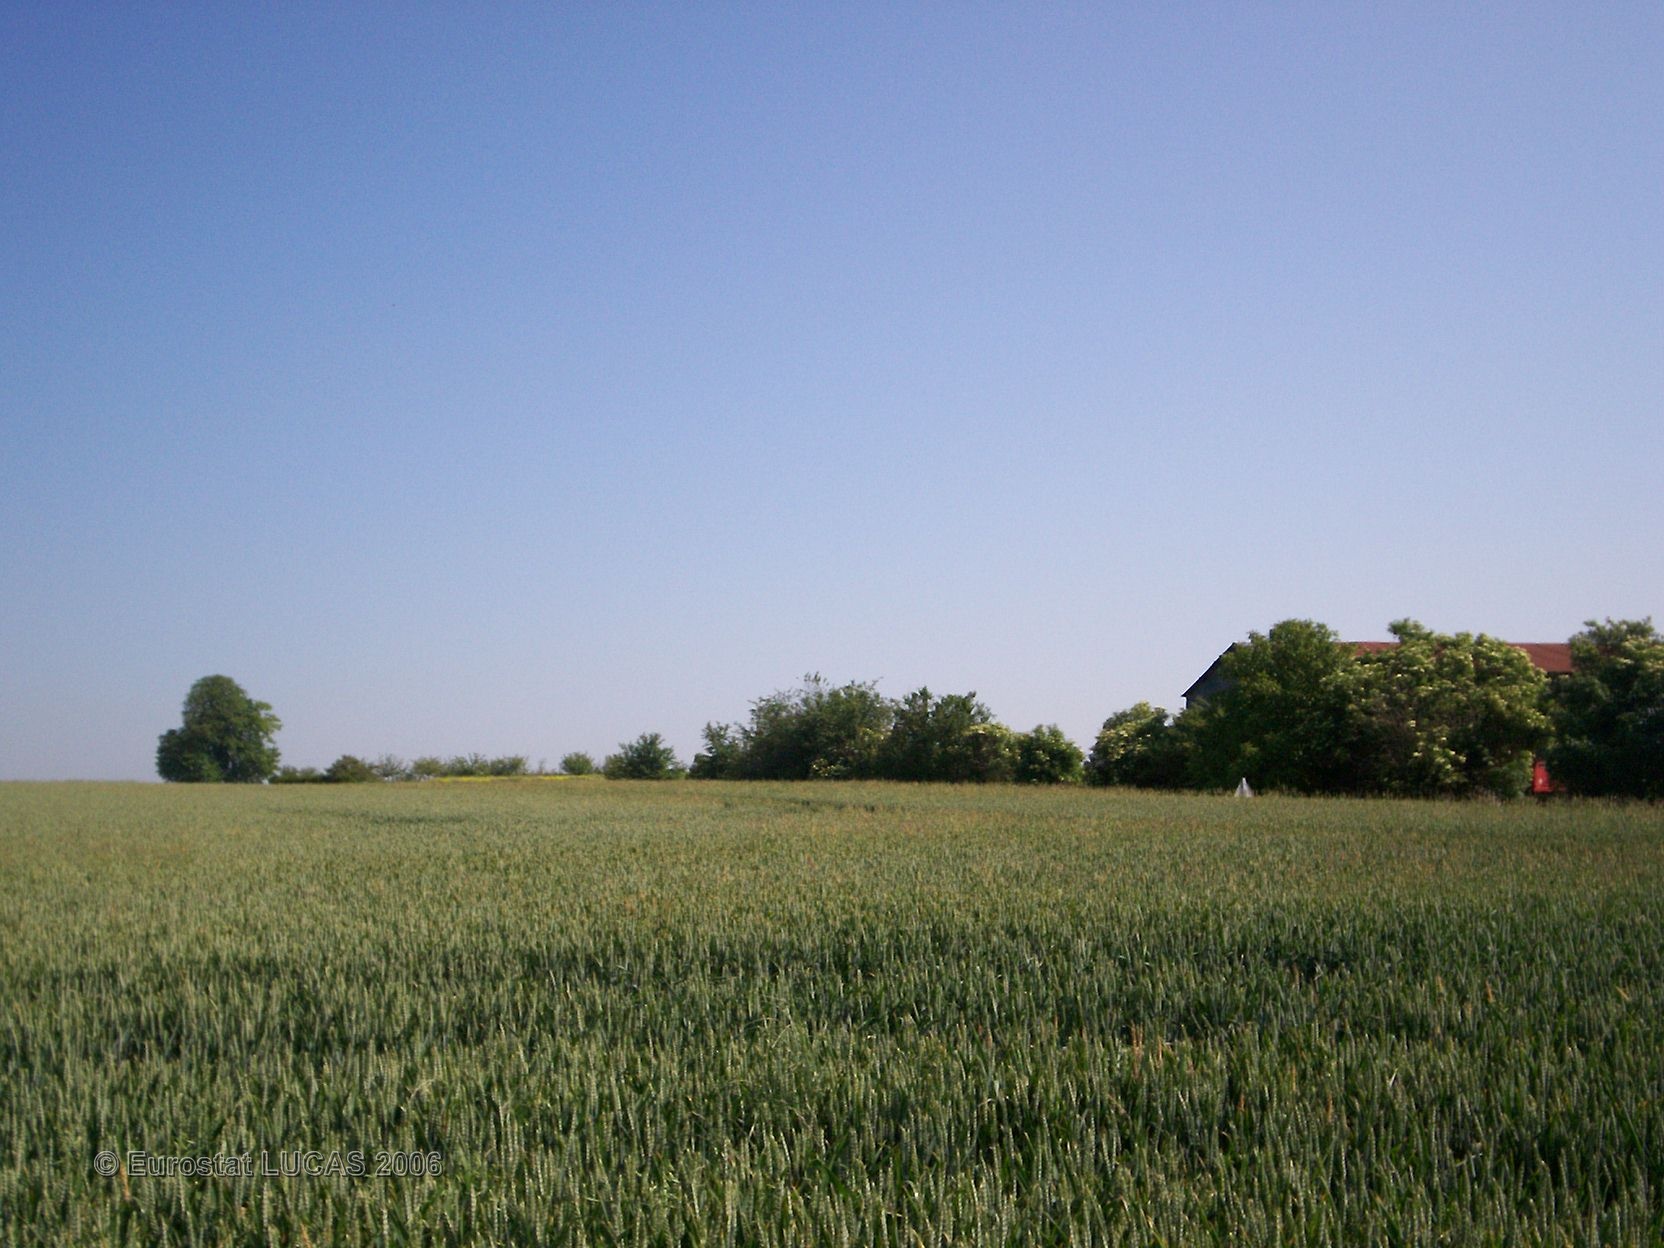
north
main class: Cropland
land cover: Common wheat
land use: Agriculture (excluding fallow land and kitchen gardens)
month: June
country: FR
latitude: 49.4959
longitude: 2.6574
